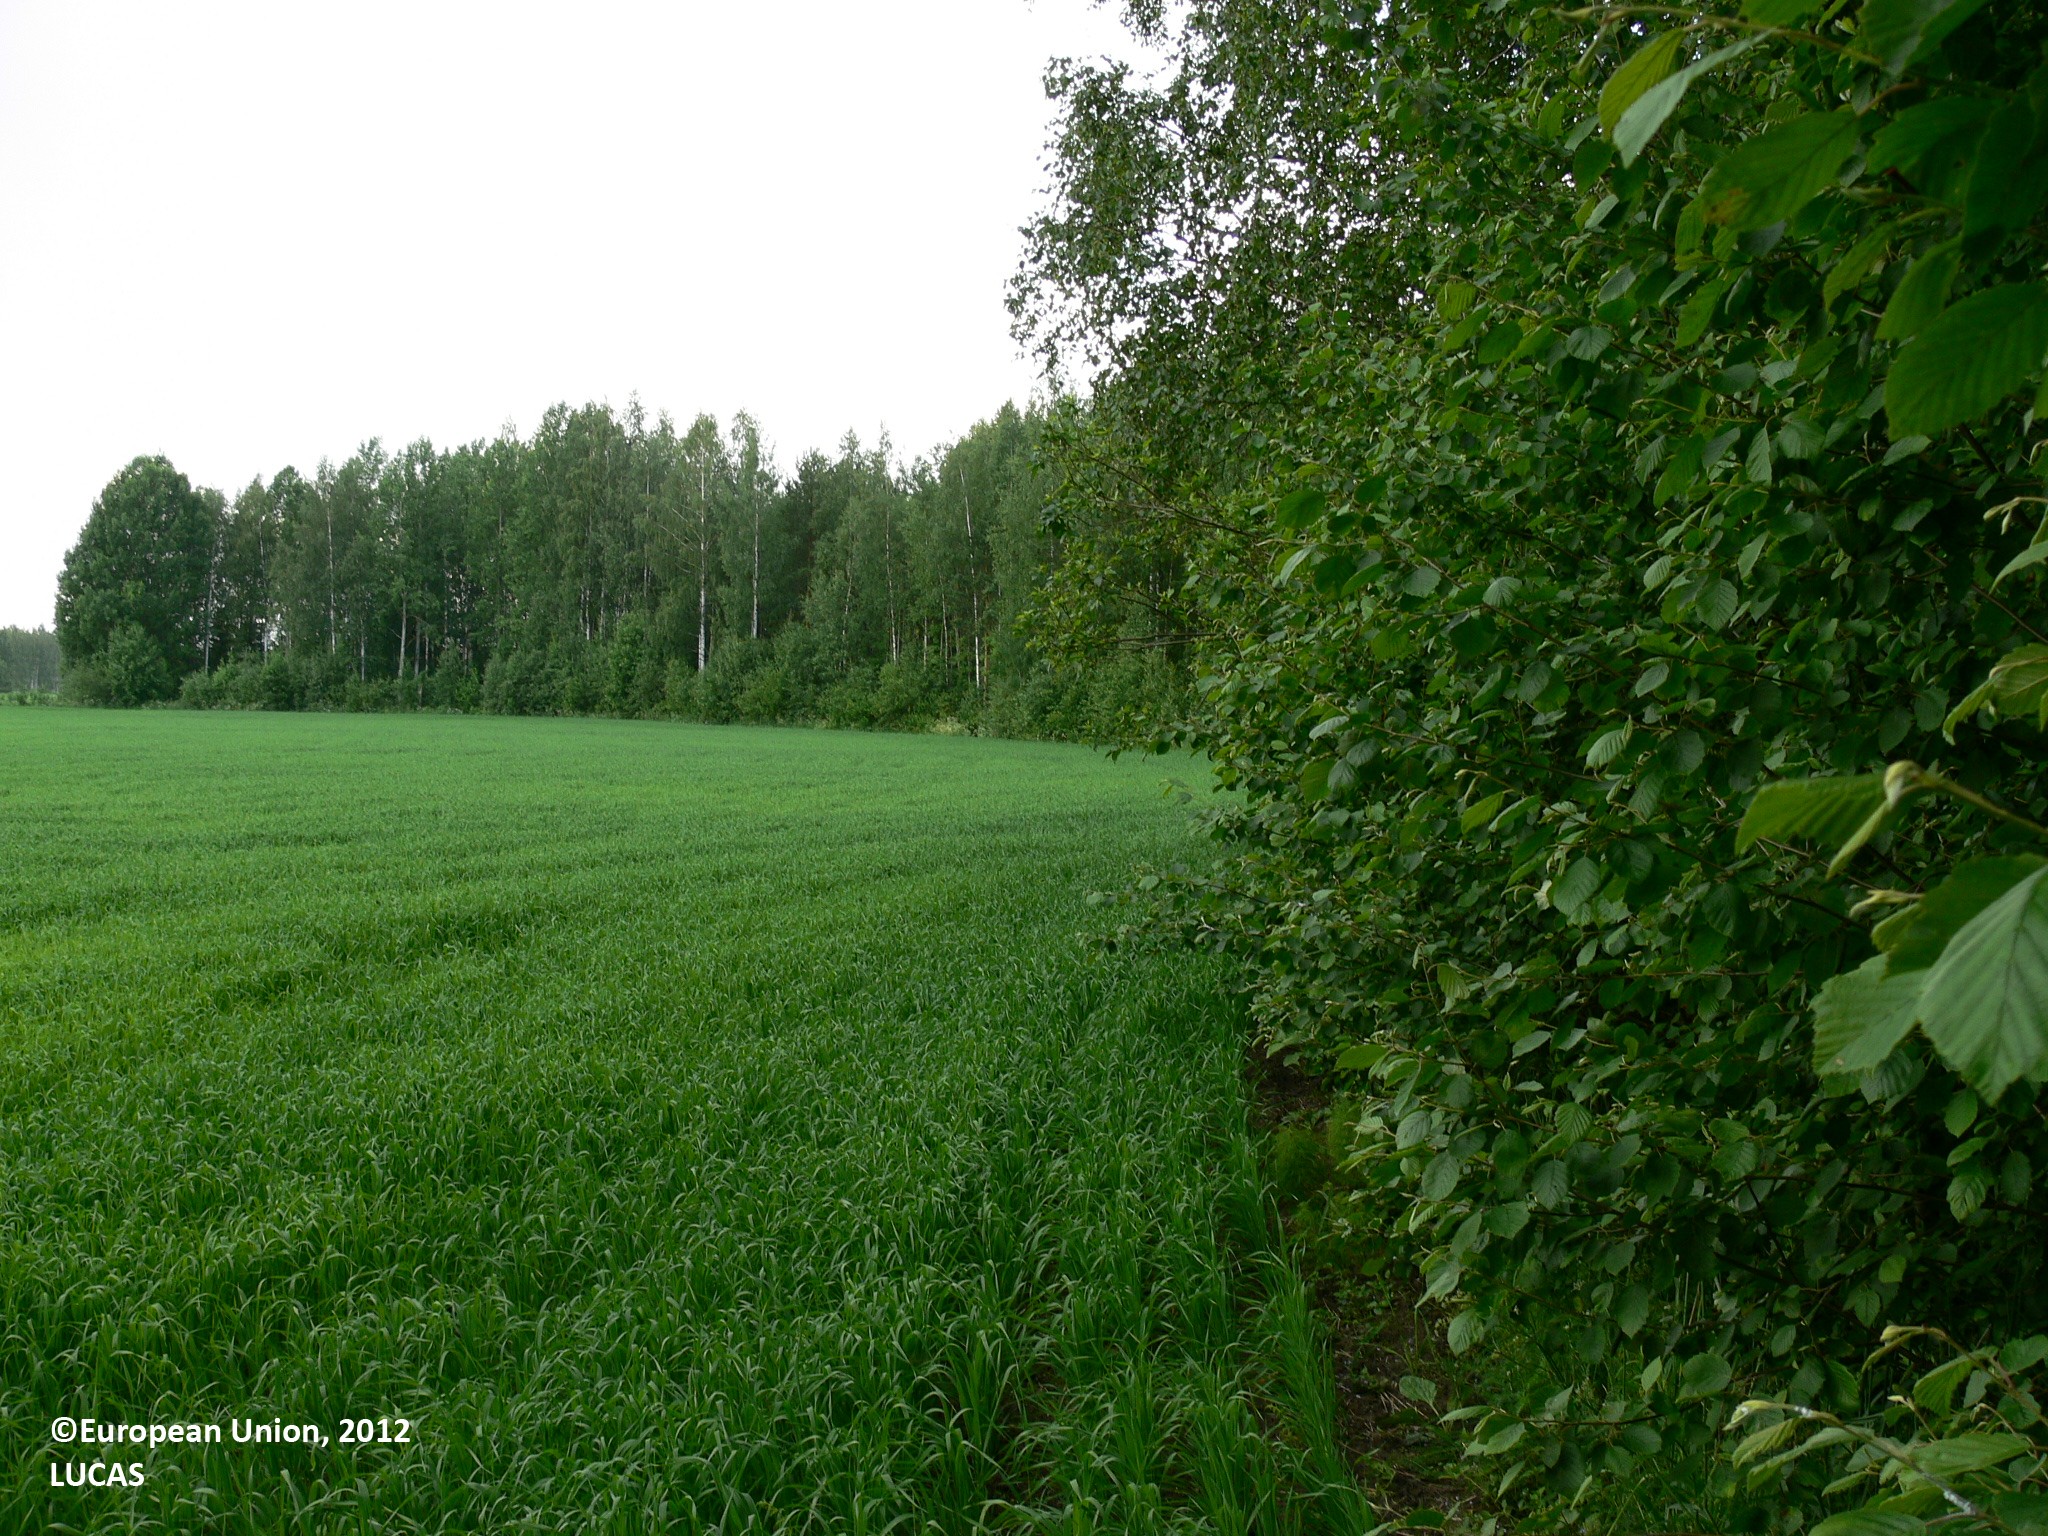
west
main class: Cropland
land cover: Oats
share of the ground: 50 - 75 %
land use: Agriculture (excluding fallow land and kitchen gardens)
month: June
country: FI
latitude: 62.4255
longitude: 29.5890
